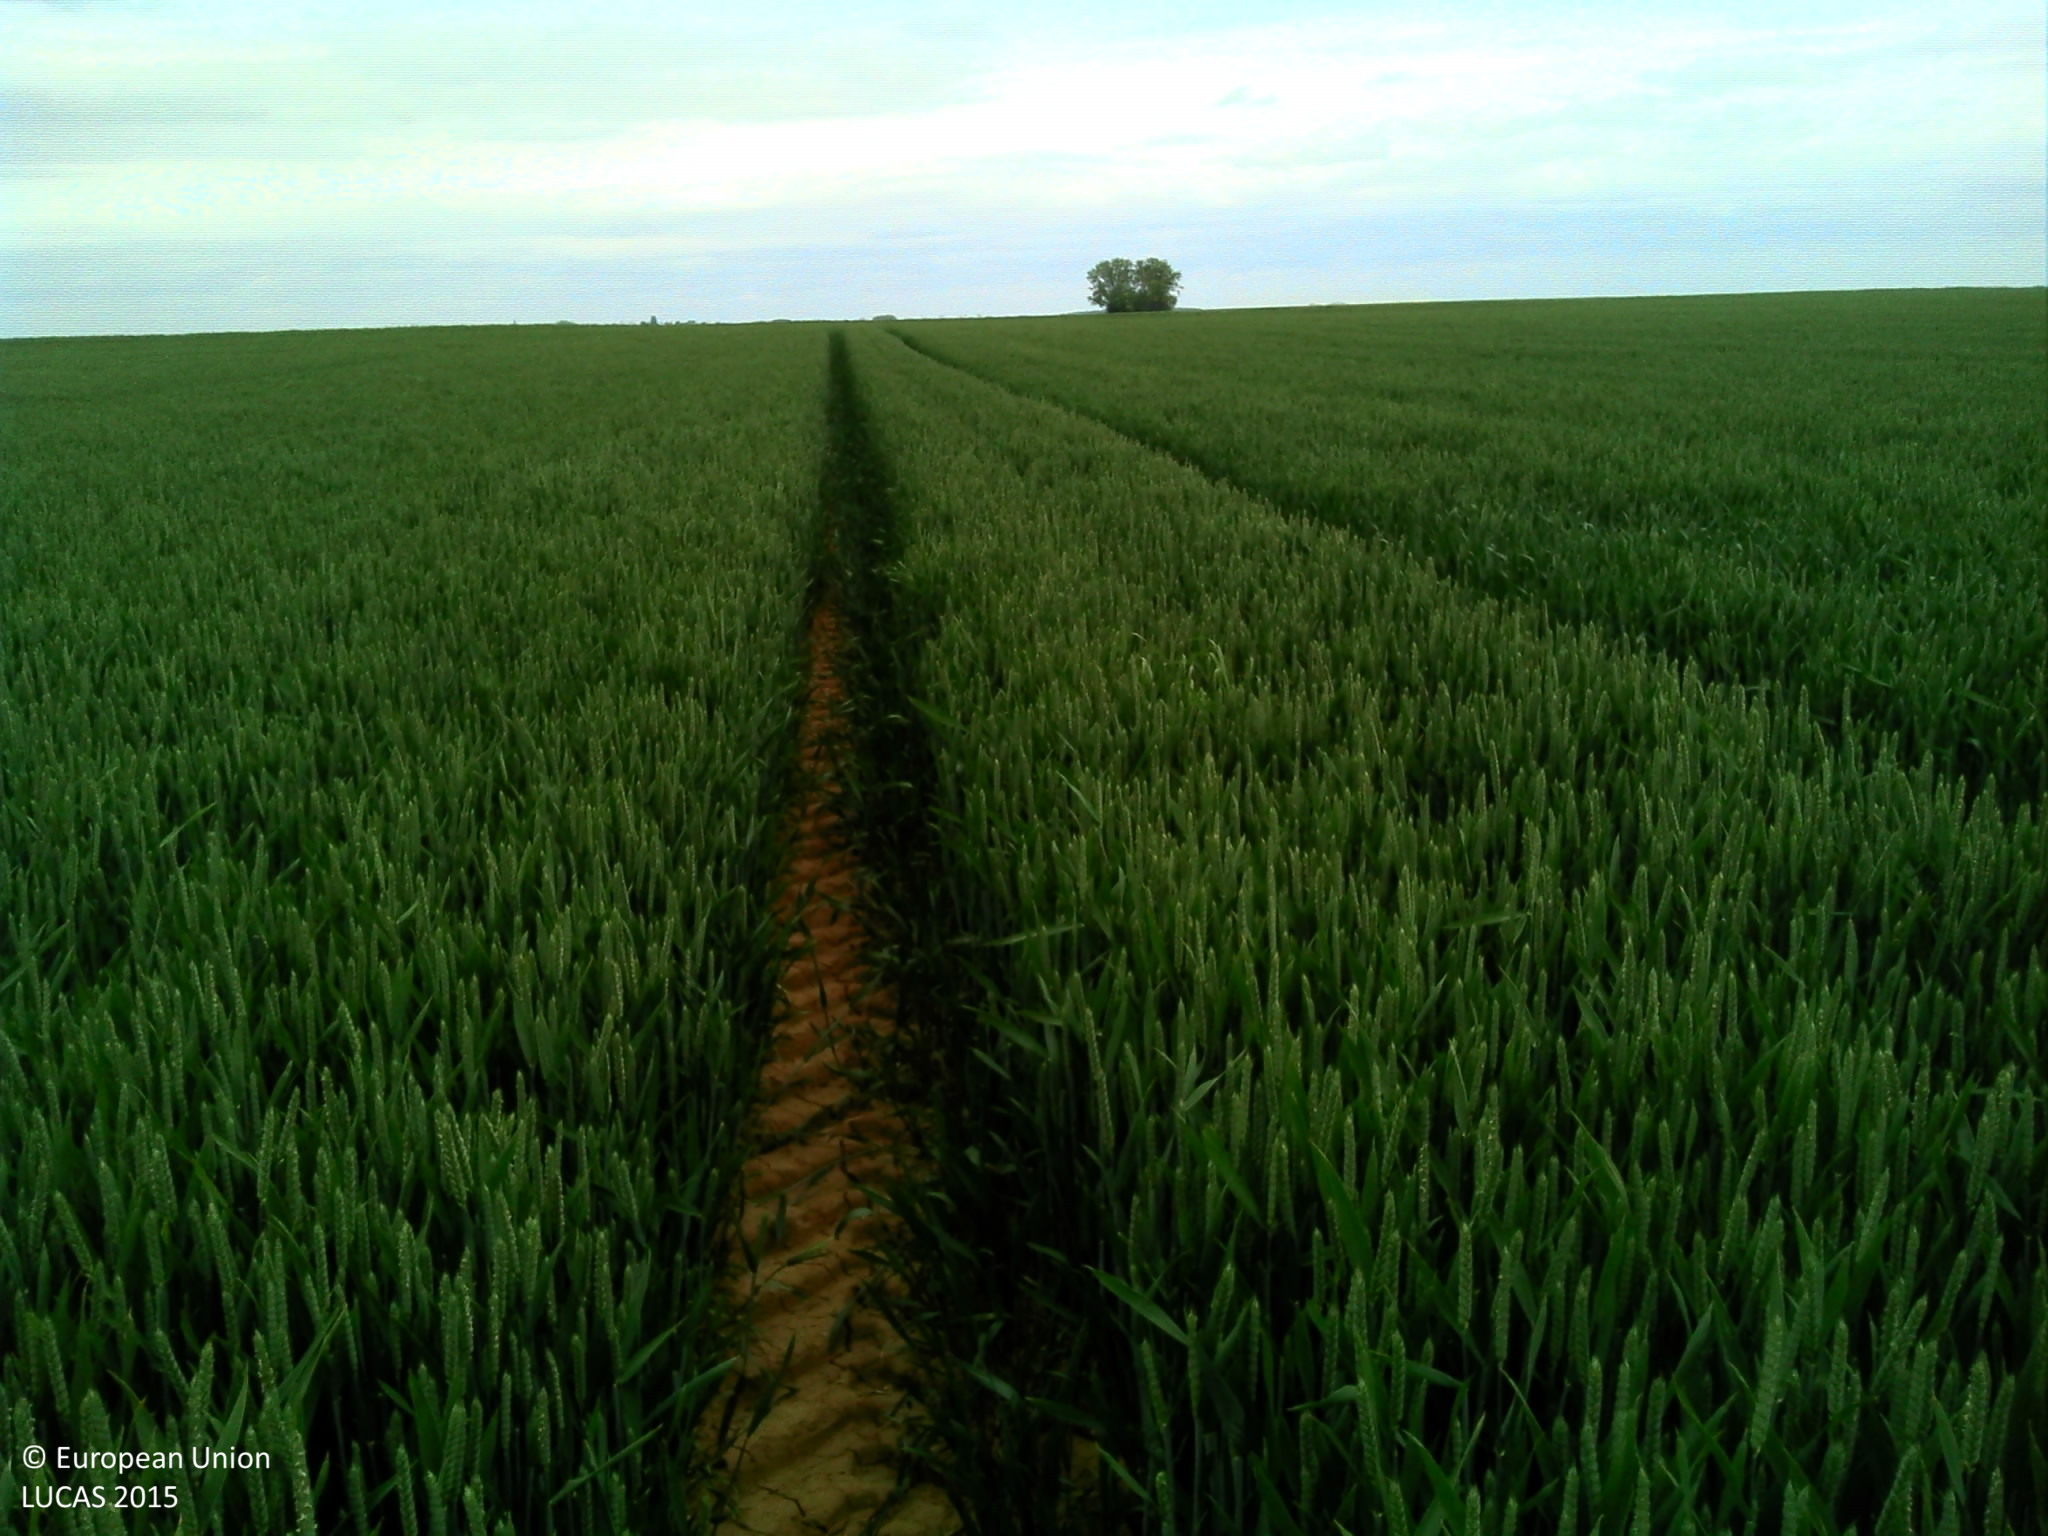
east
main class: Cropland
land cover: Common wheat
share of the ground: > 75 %
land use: Agriculture (excluding fallow land and kitchen gardens)
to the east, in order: Common wheat; Grass margins; Paved roads, cycling and walking lanes; Grass margins; Other bare soil; Common wheat
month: May
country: FR
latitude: 49.7664
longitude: 3.2301
